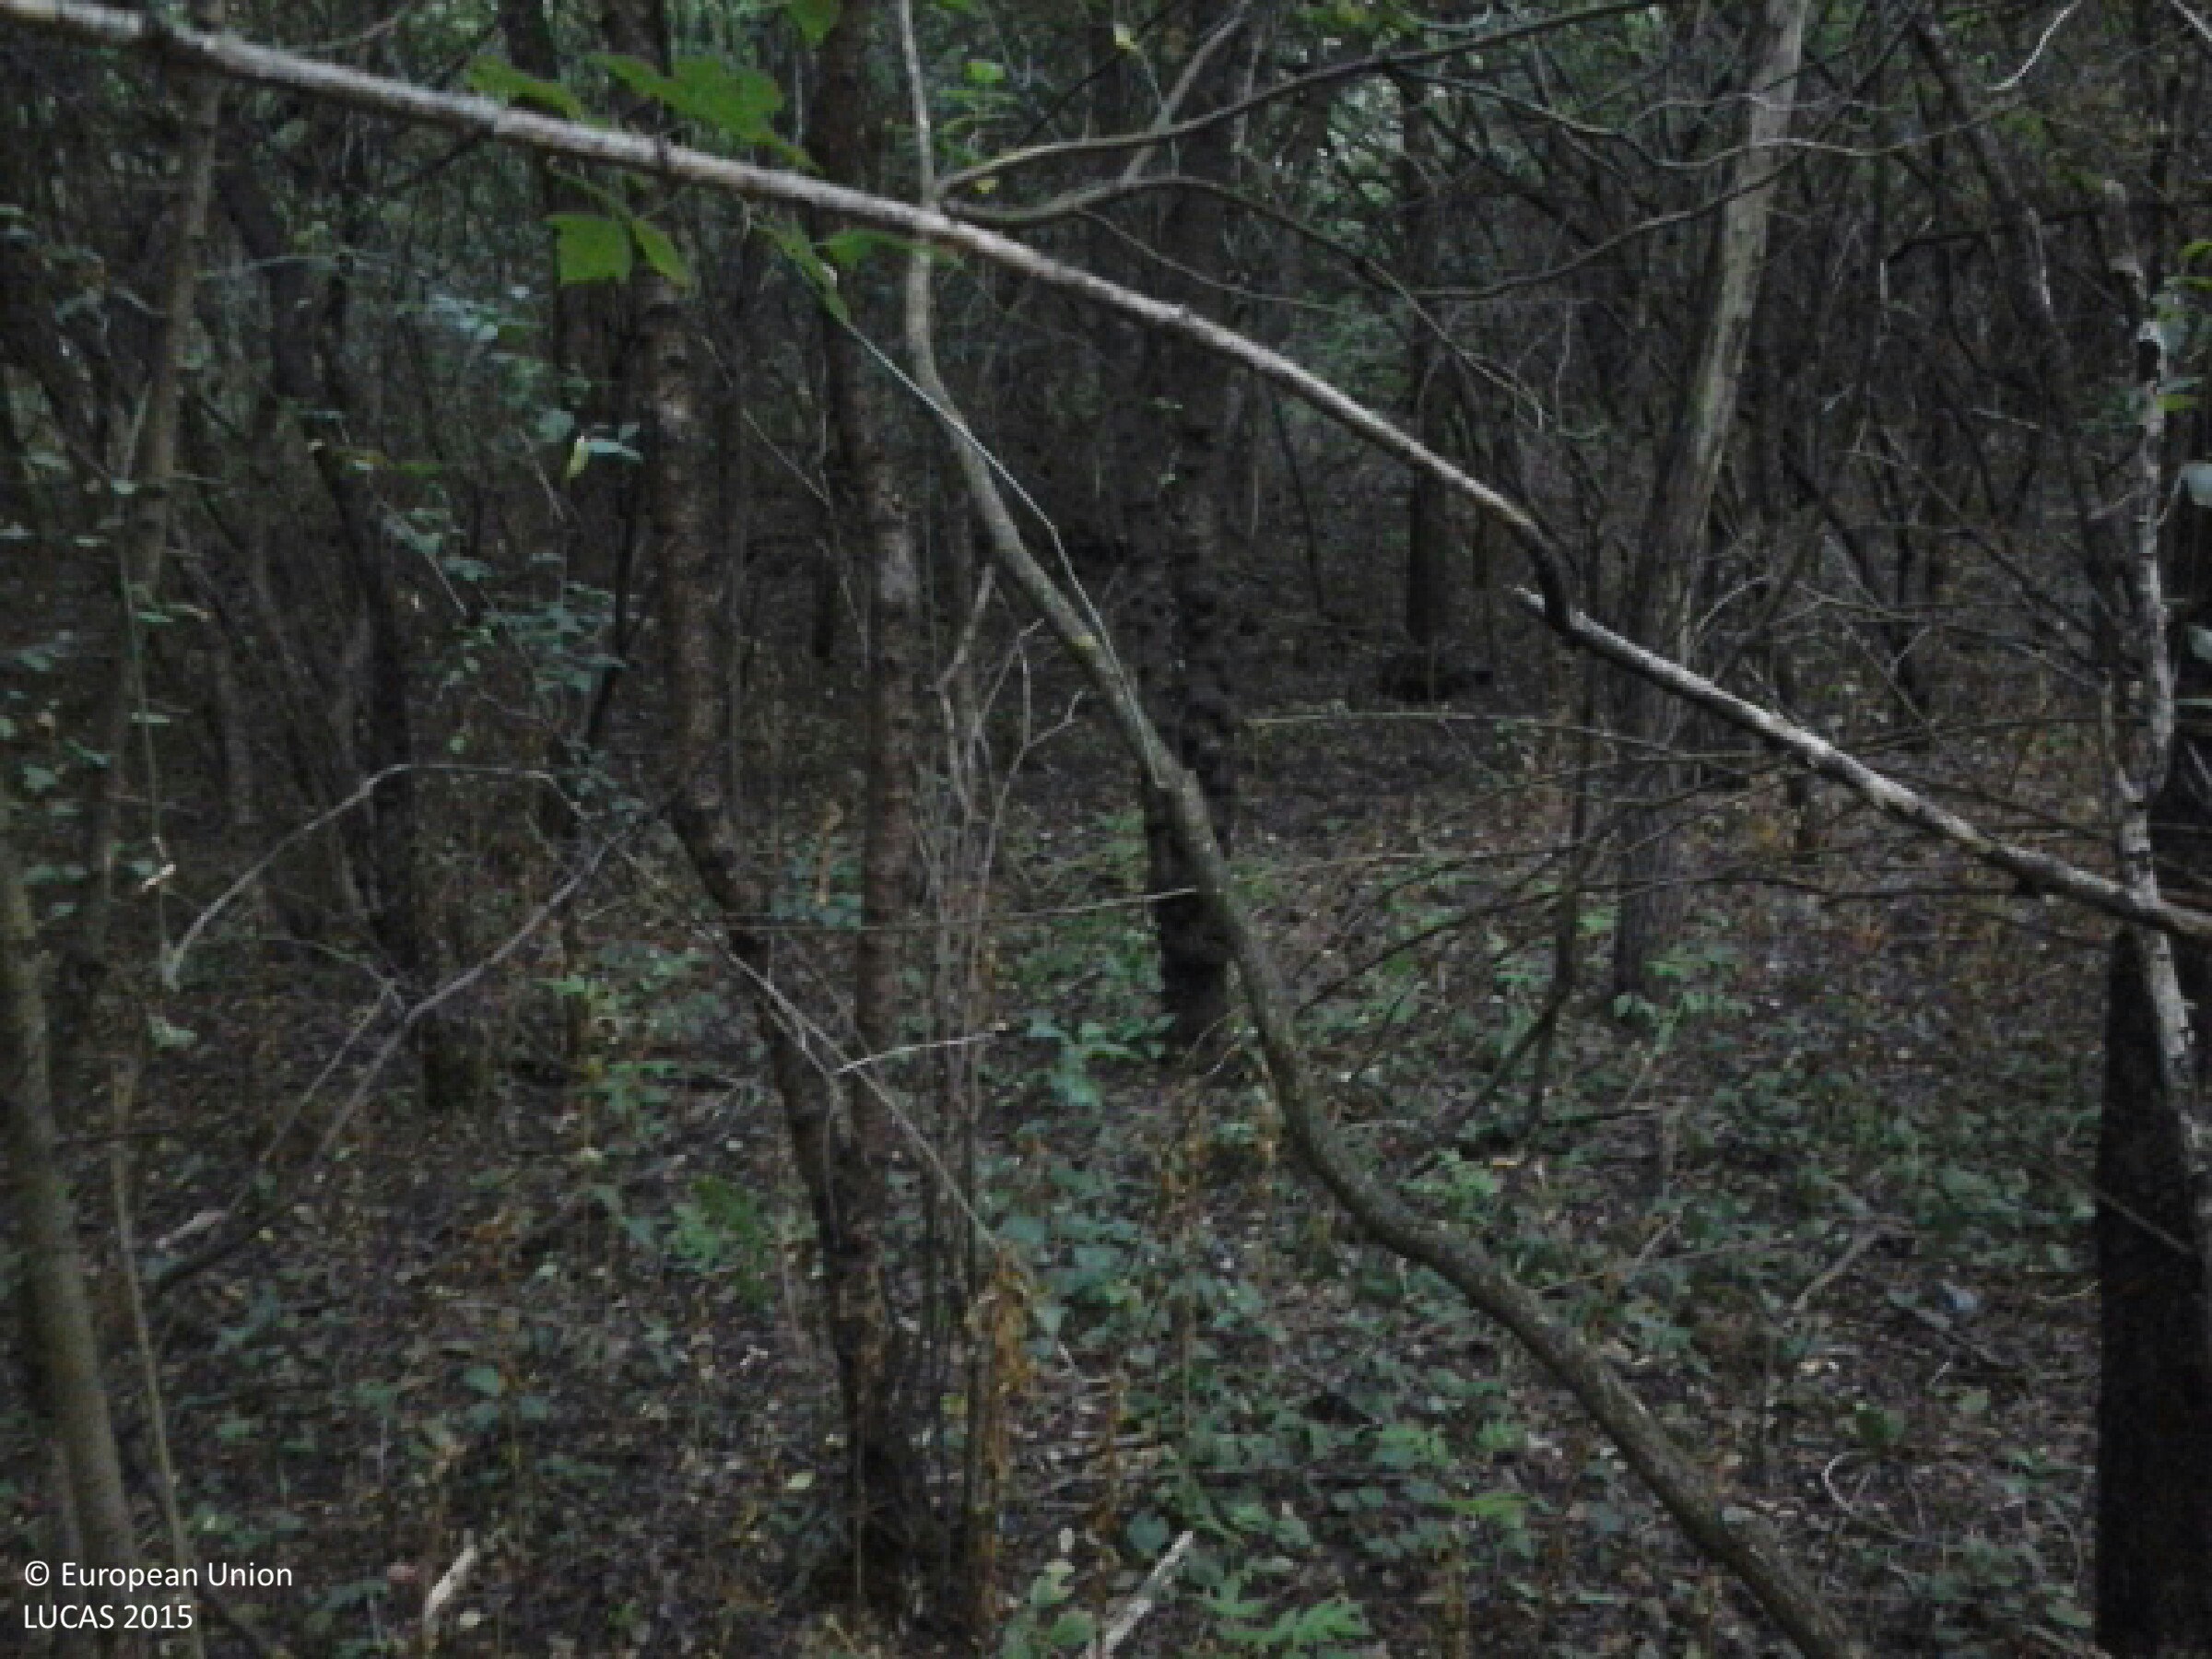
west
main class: Woodland
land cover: Broadleaved woodland
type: mesophytic deciduous forest
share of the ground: > 75 %
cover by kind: broadleaved forest trees 95 %, herbaceous plants 5 %
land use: Forestry
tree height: > 5 m
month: August
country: HU
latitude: 47.7298
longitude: 18.0518
